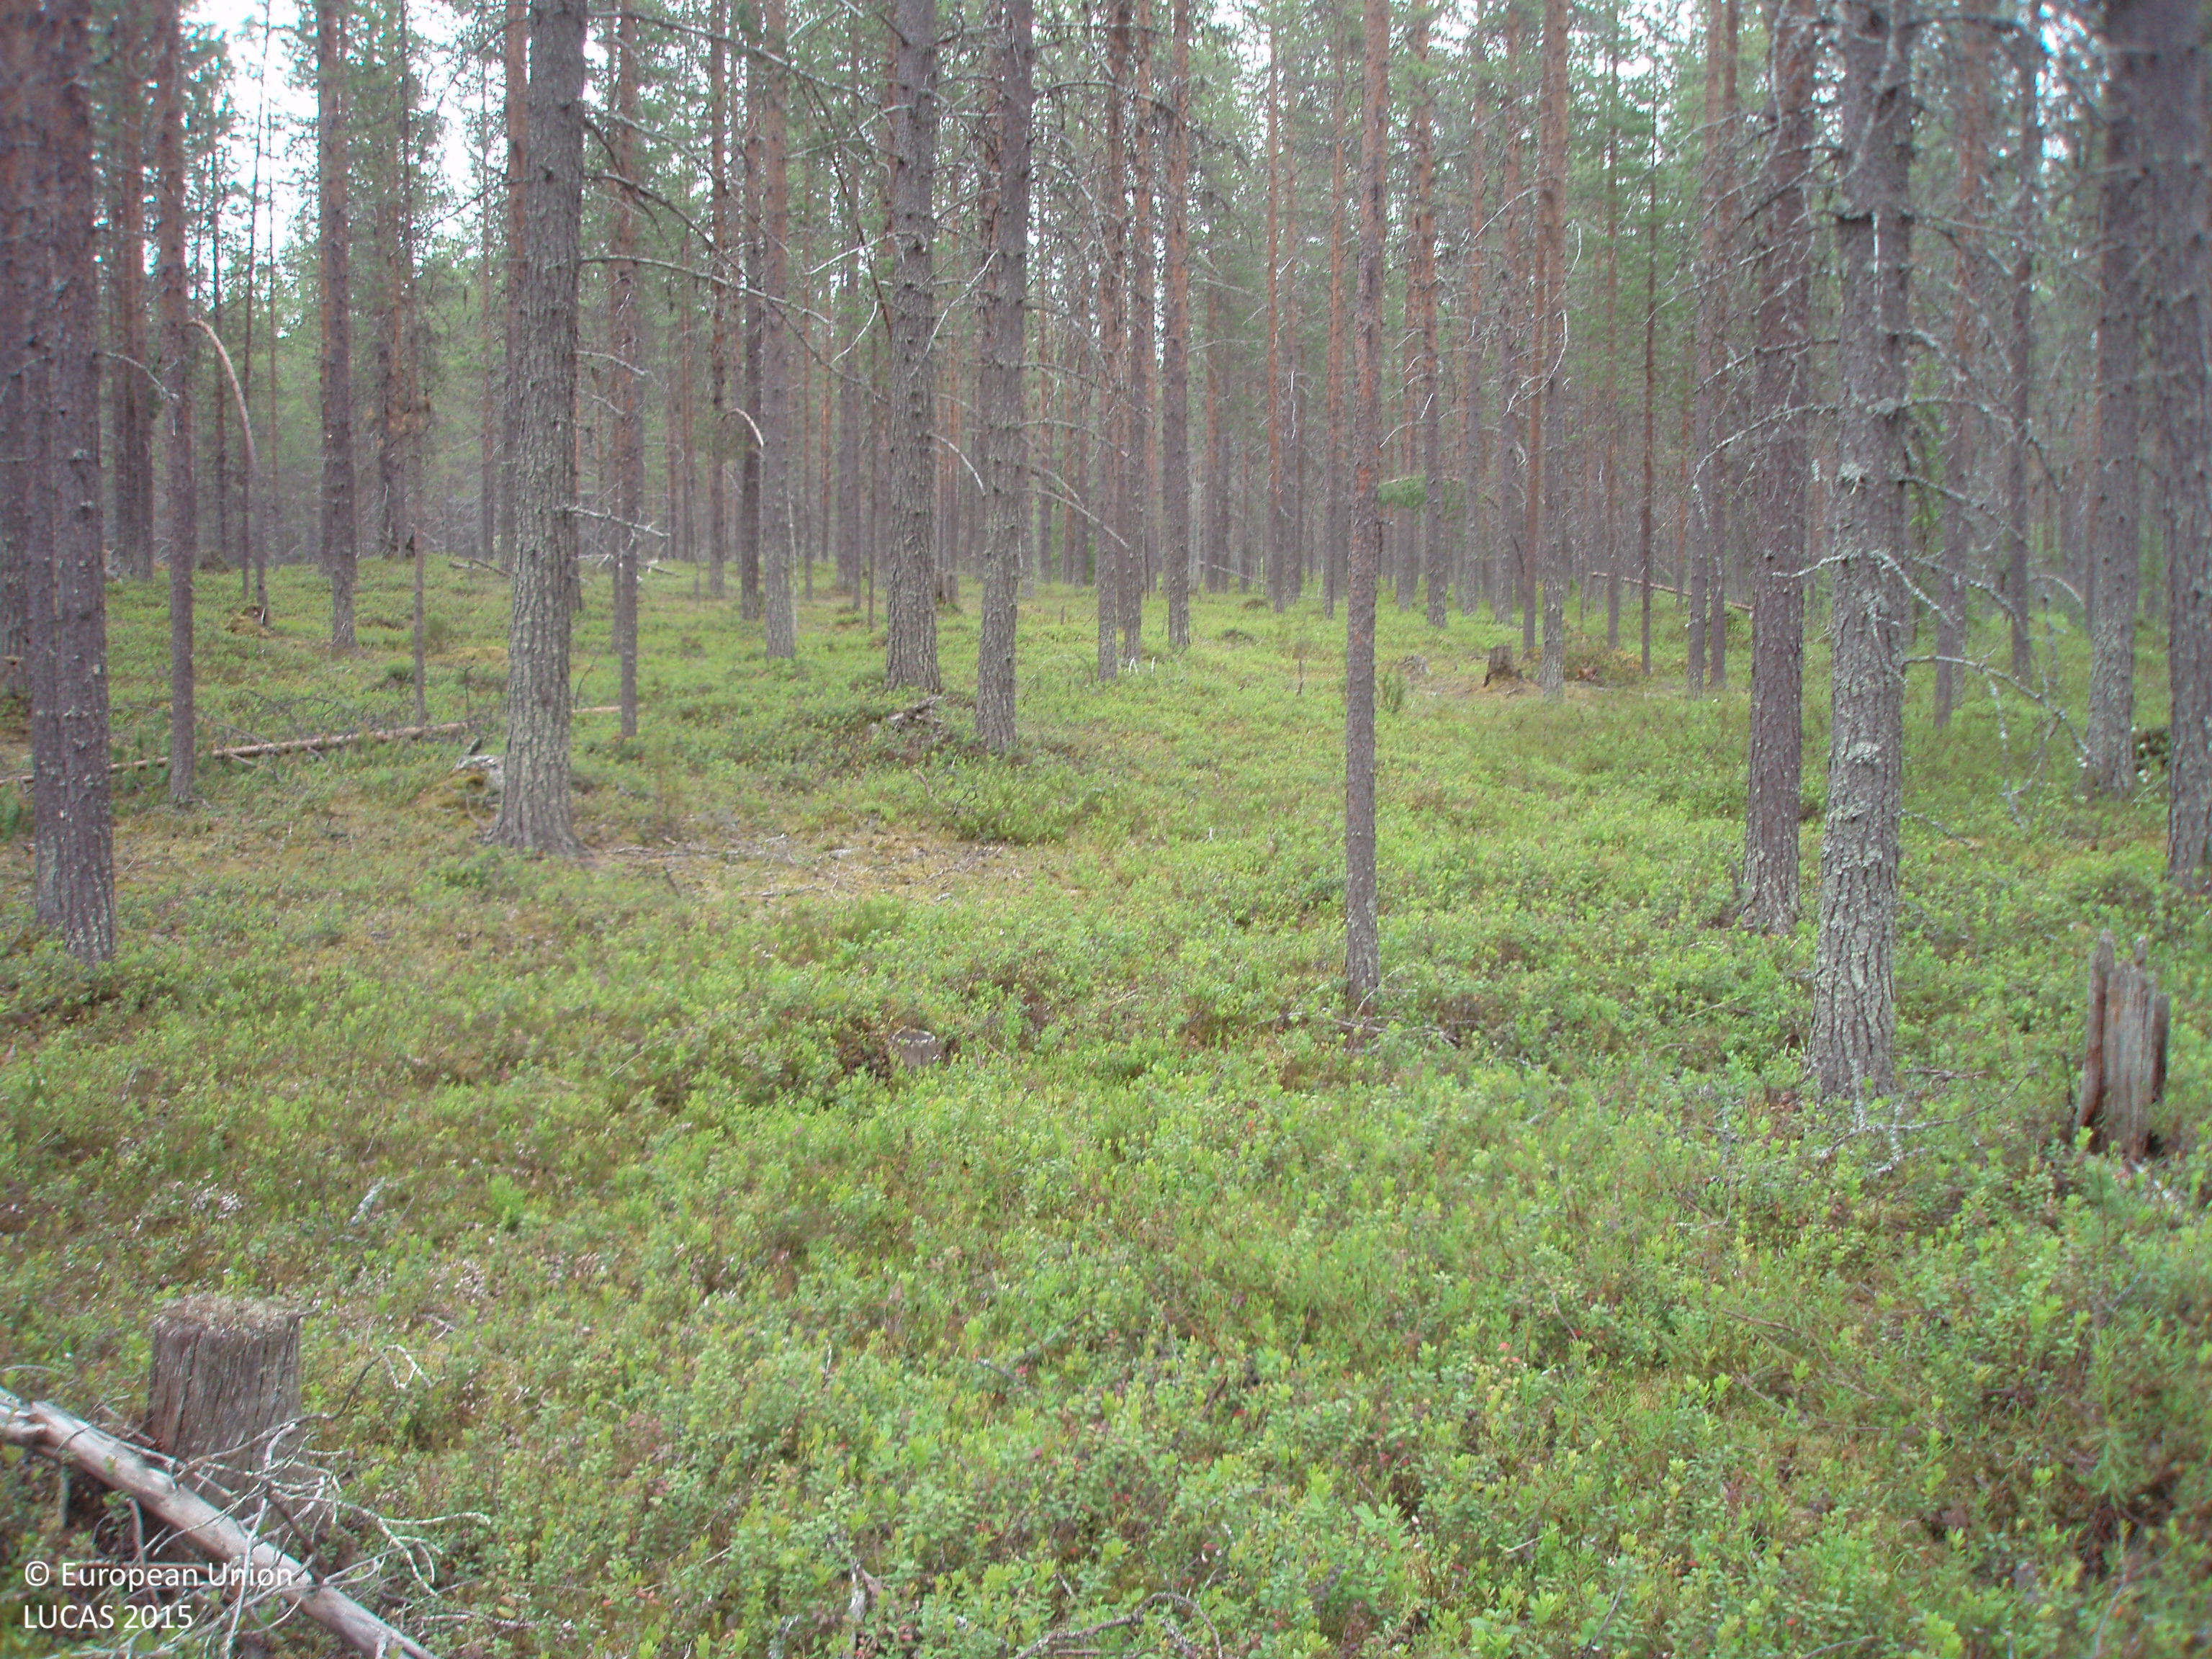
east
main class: Woodland
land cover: Pine dominated coniferous woodland
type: boreal forest
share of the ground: > 75 %
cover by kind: coniferous forest trees 75 %, shrubs 25 %
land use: Forestry
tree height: > 5 m
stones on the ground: < 10 %
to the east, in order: Pine dominated coniferous woodland; Ditches and canals; Pine dominated mixed woodland
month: July
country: FI
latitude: 67.3108
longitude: 28.2202
